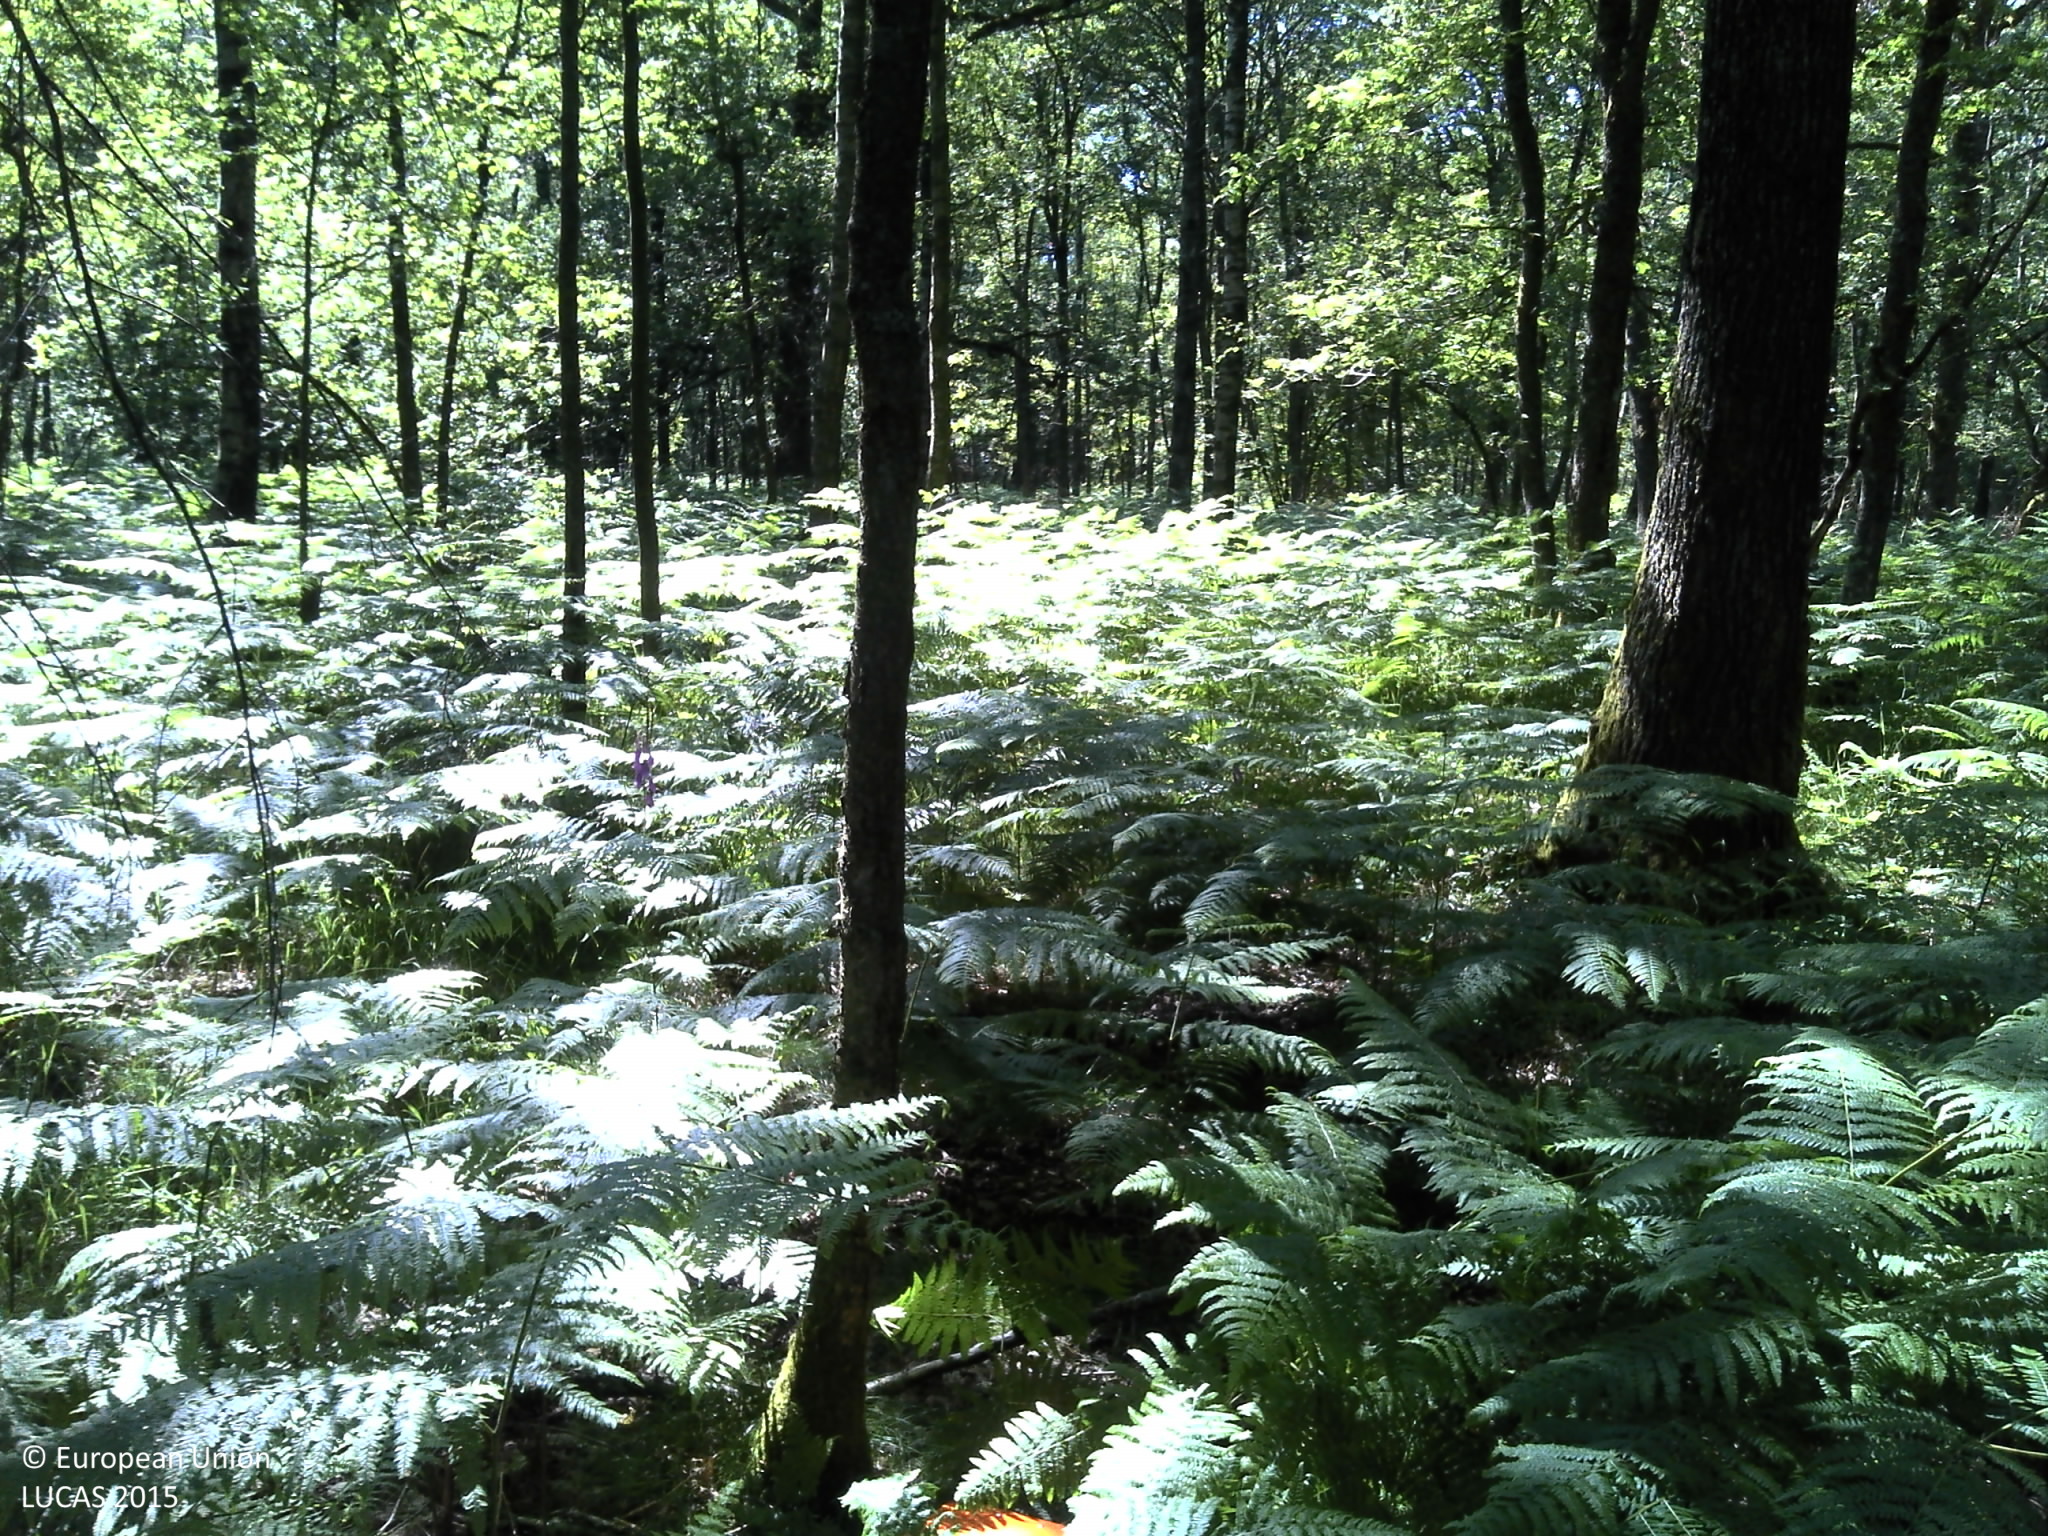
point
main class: Woodland
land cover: Broadleaved woodland
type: acidophilous oak and oak-birch forest
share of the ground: 25 - 50 %
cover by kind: broadleaved forest trees 65 %, herbaceous plants 25 %, consolidated bare surface 10 %
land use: Forestry
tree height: > 5 m
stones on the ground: 10 - 25 %
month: June
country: FR
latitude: 49.9933
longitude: 4.7938
